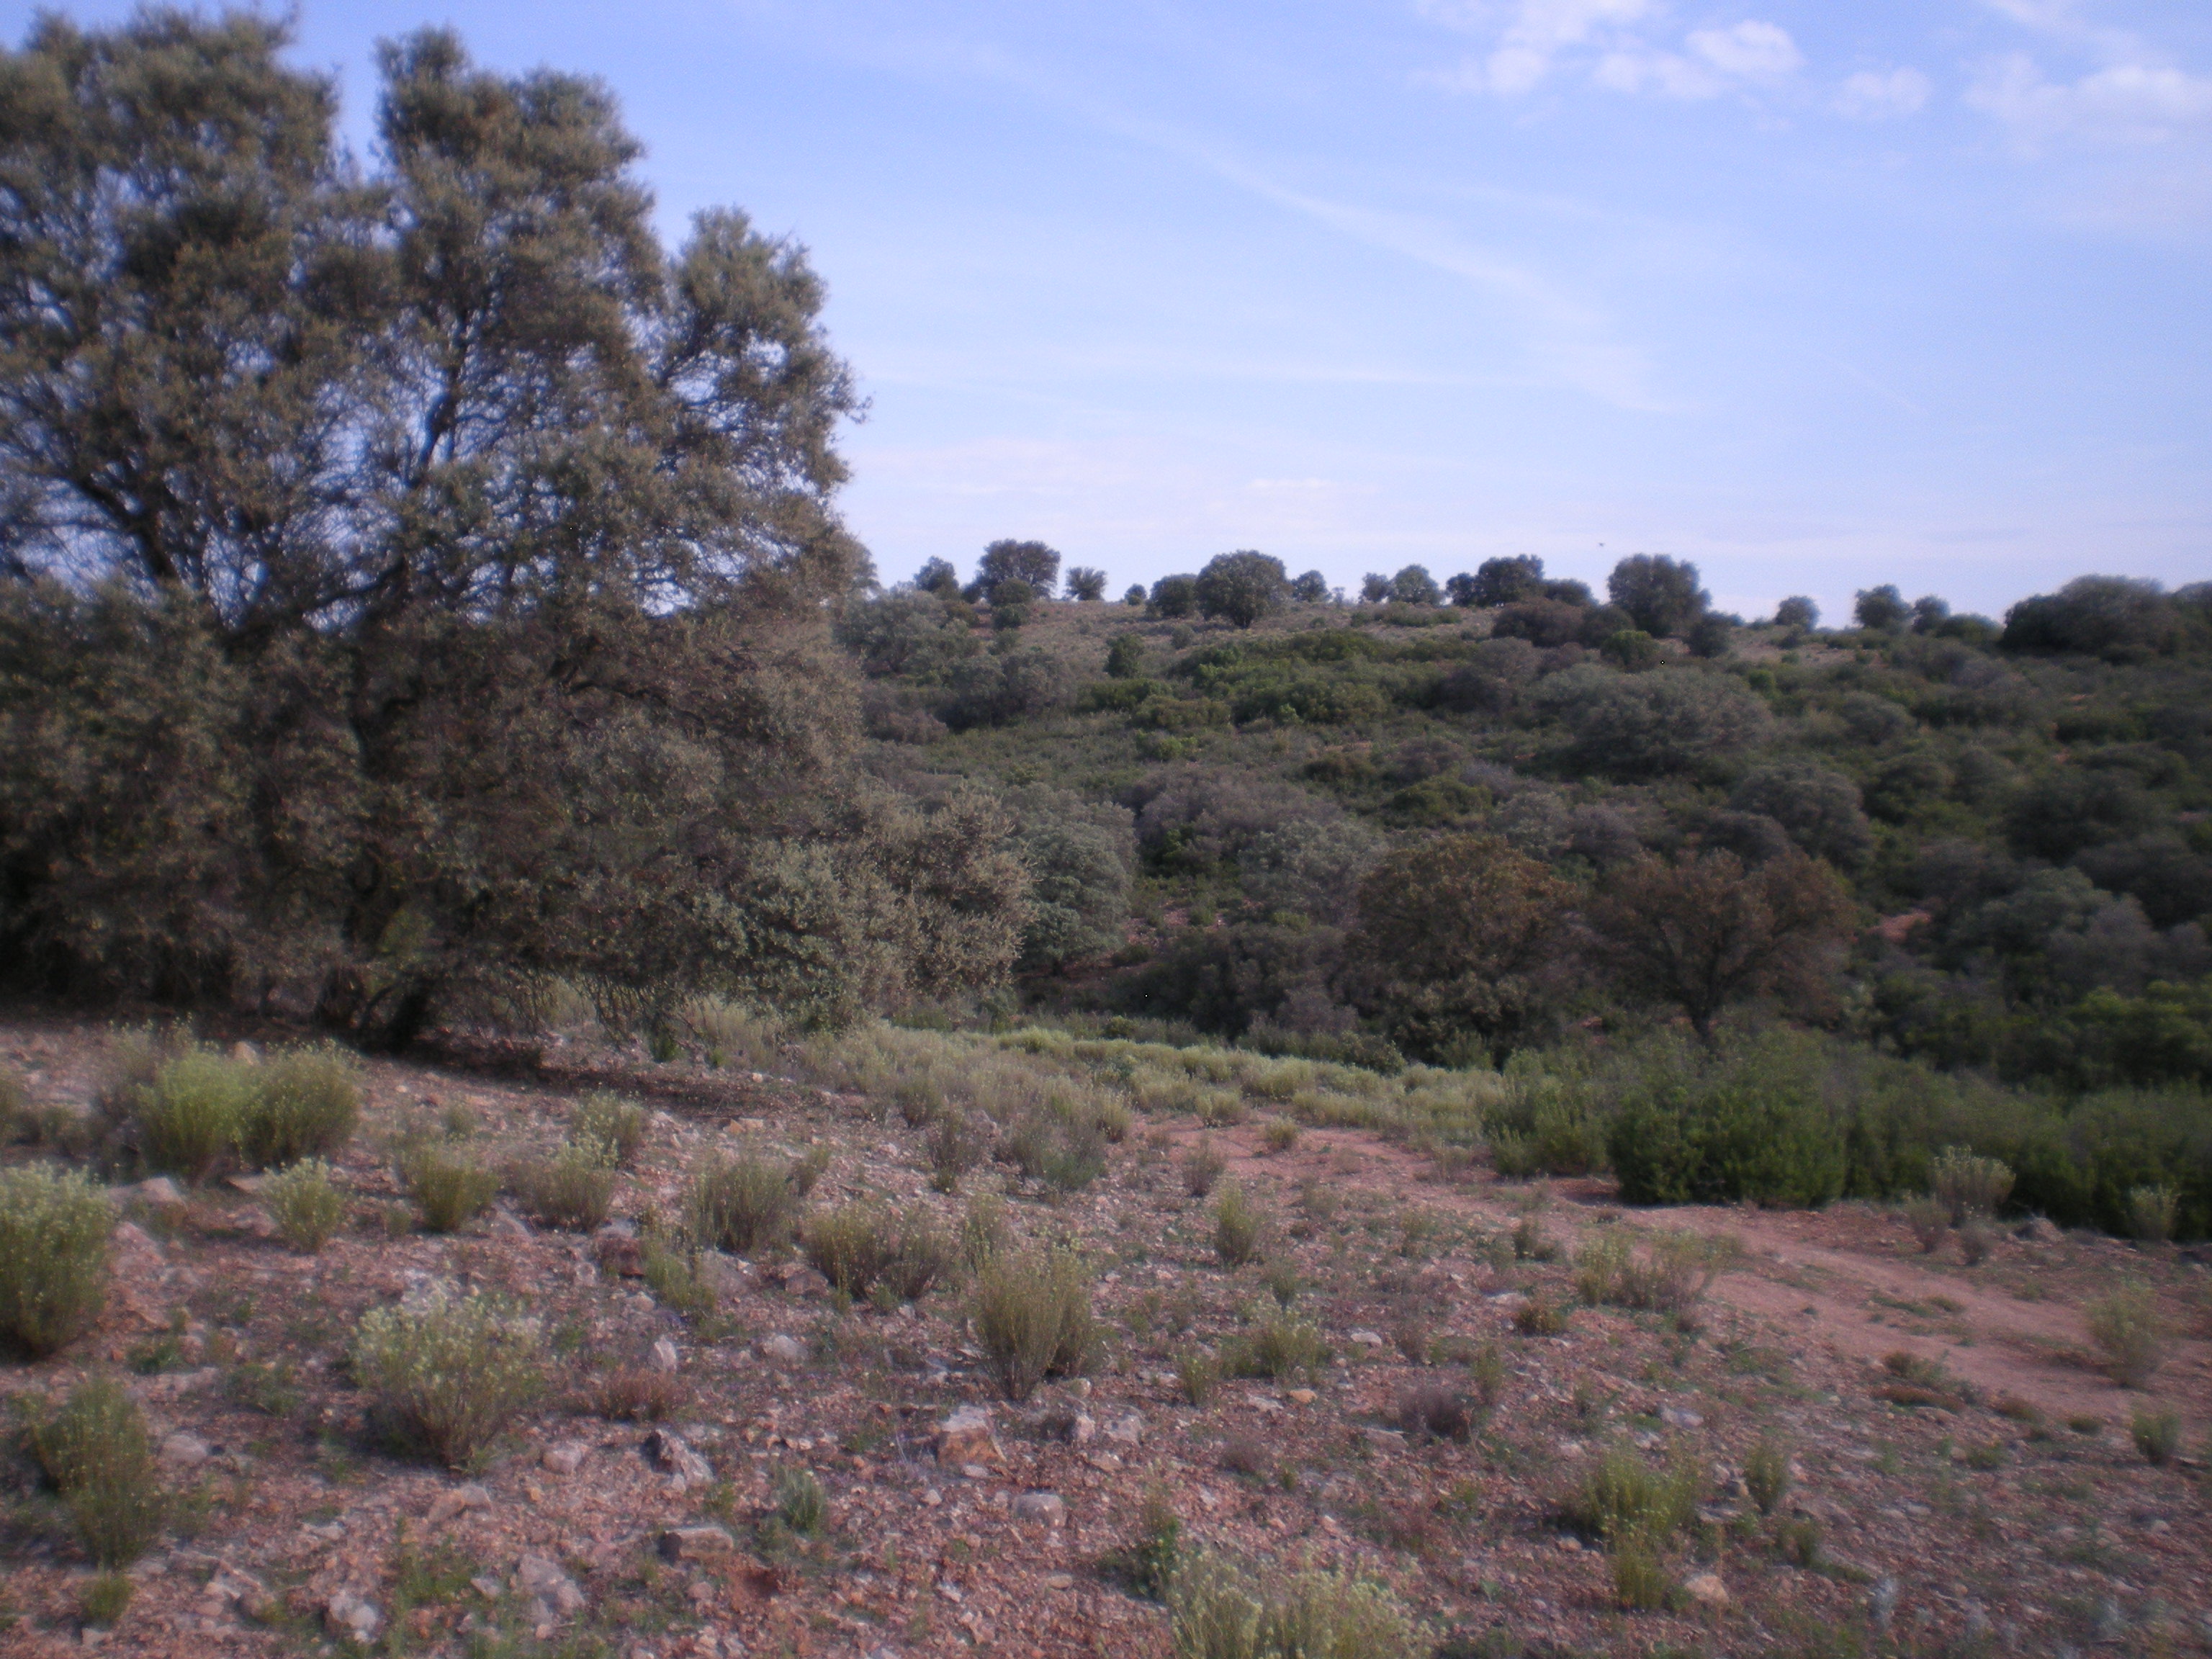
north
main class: Shrubland
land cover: Shrubland with sparse tree cover
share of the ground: 25 - 50 %
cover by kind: unconsolidated bare surface 40 %, herbaceous plants 35 %, shrubs 20 %, broadleaved forest trees 5 %
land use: Semi-natural and natural areas not in use
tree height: < 5 m
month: May
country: ES
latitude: 39.0018
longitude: -2.9541
